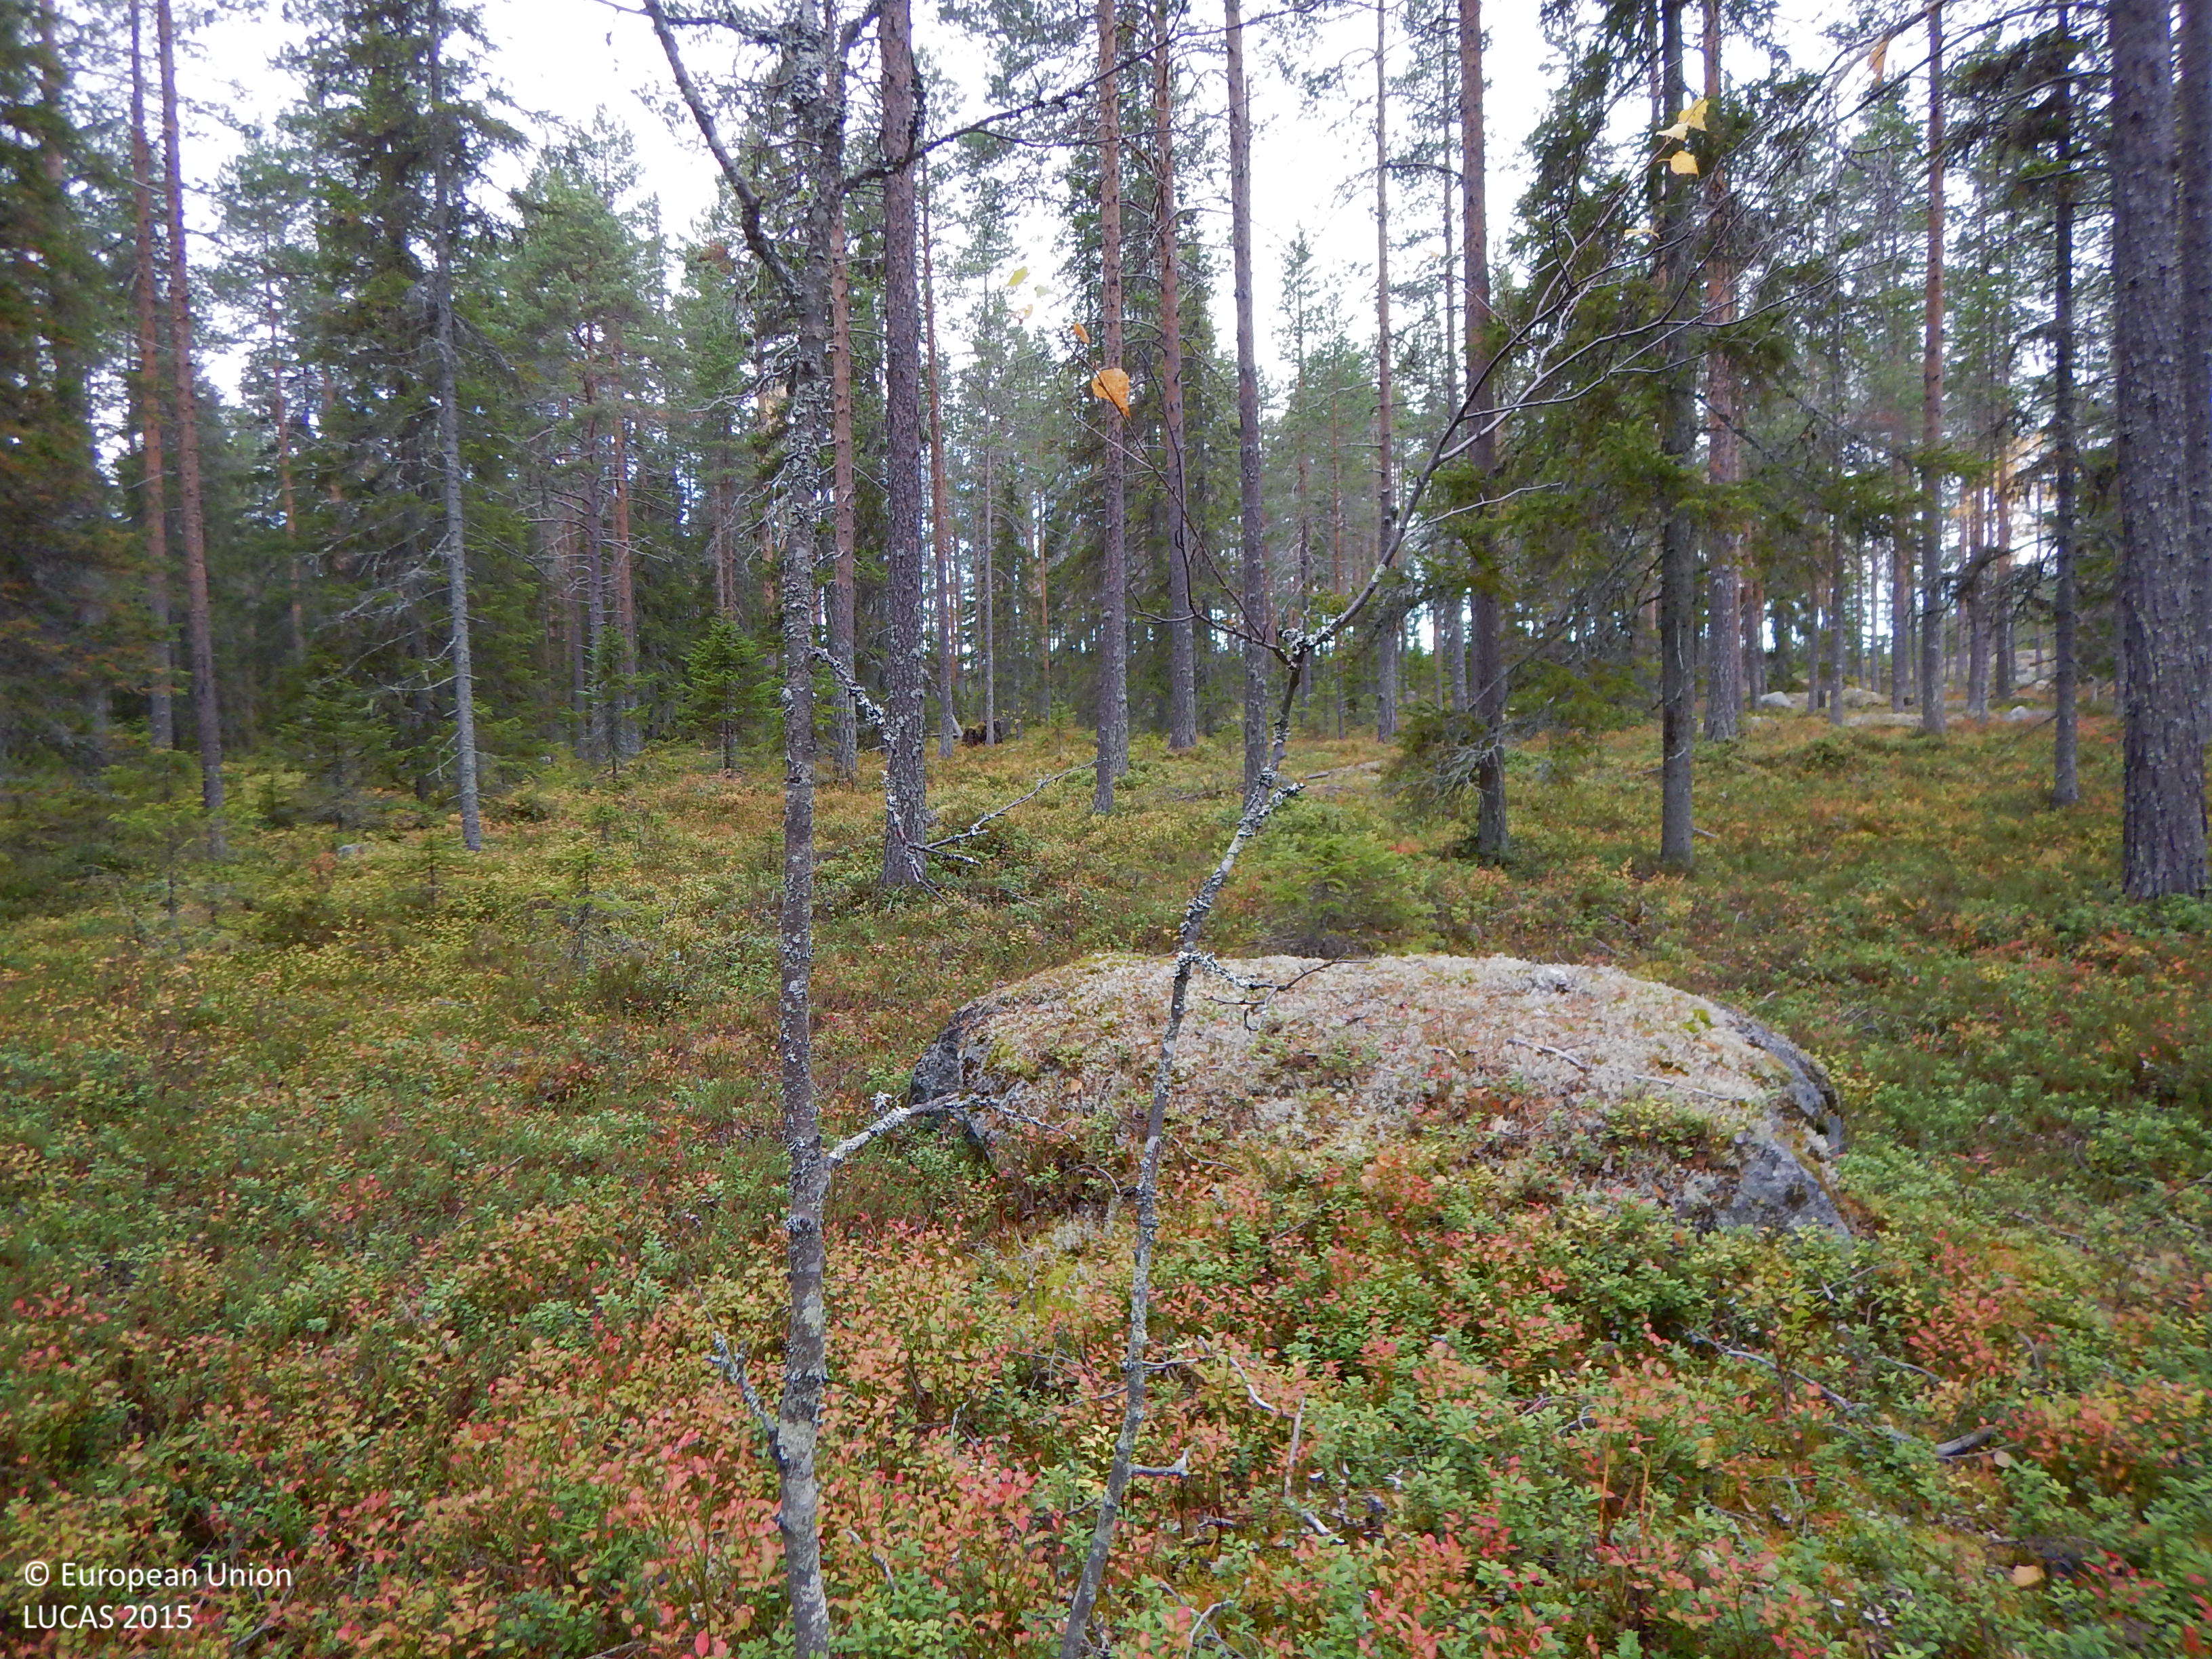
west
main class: Woodland
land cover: Pine dominated coniferous woodland
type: boreal forest
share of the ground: 50 - 75 %
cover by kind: coniferous forest trees 65 %, shrubs 15 %, lichens and mosses 15 %, herbaceous plants 5 %
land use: Forestry
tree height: > 5 m
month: October
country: SE
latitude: 64.9616
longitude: 21.0517
